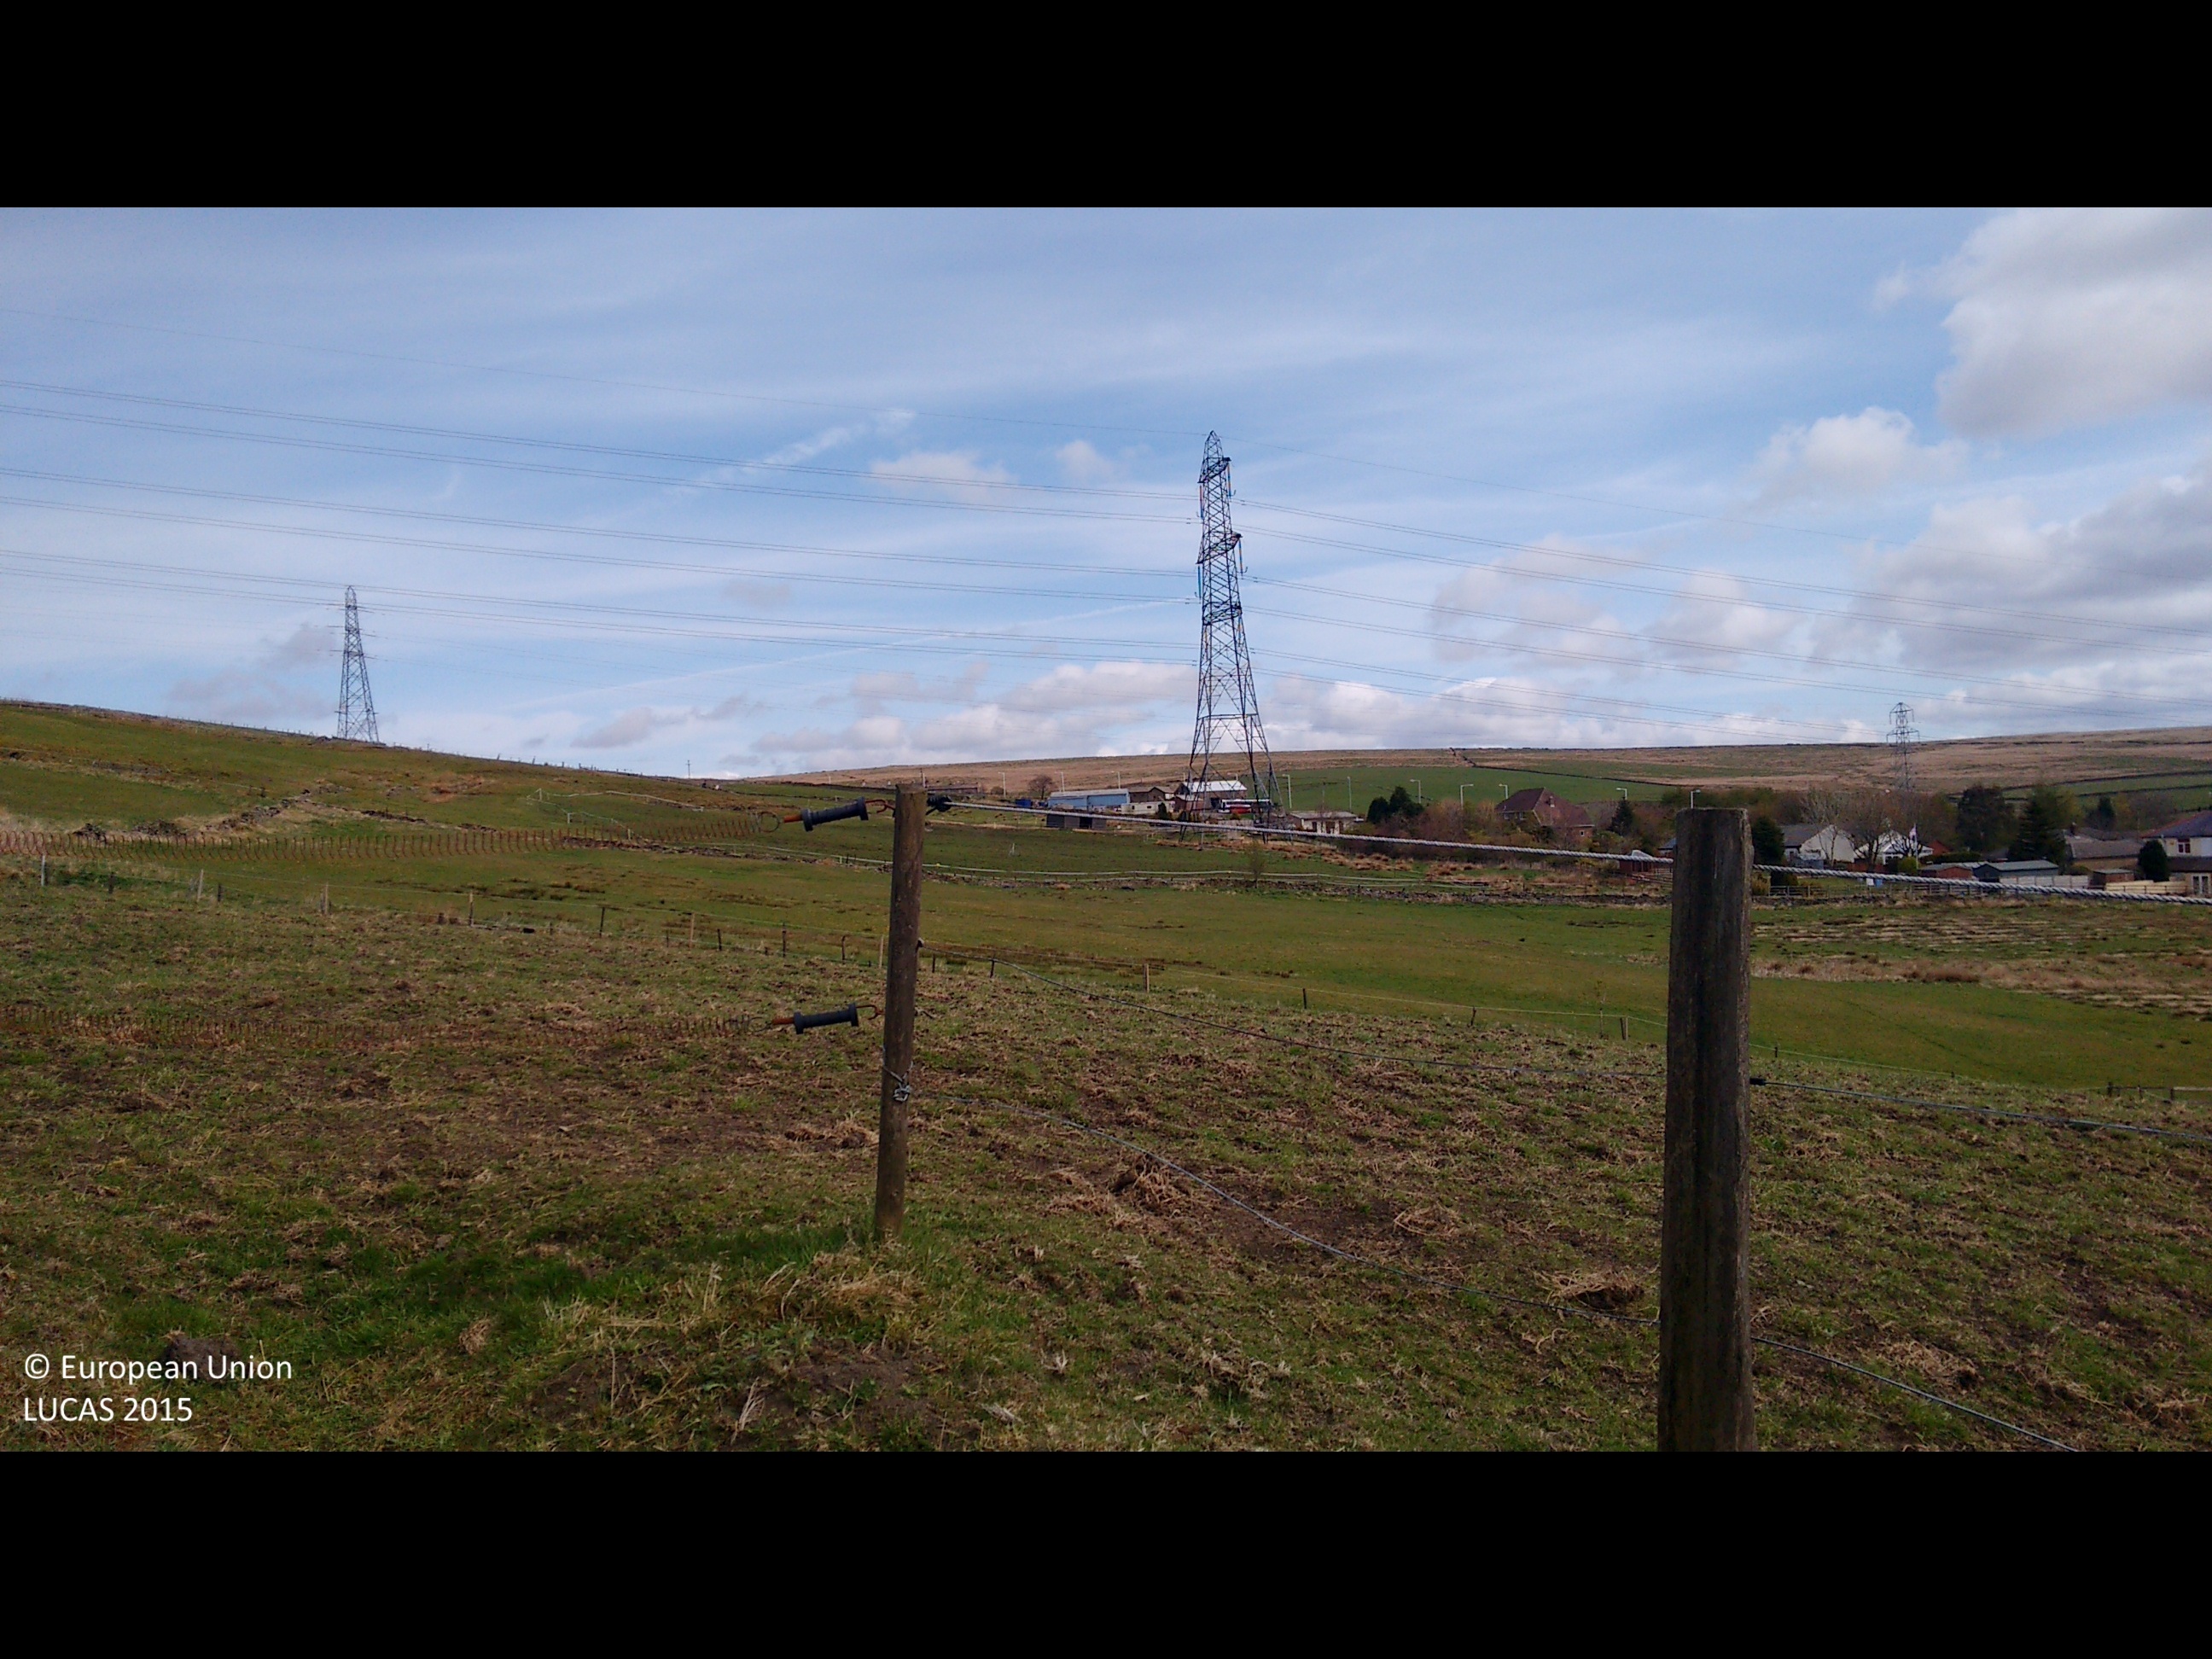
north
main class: Grassland
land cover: Grassland without tree/shrub cover
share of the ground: > 75 %
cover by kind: herbaceous plants 100 %
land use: Agriculture (excluding fallow land and kitchen gardens)
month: May
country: GB
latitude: 53.7282
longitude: -2.2011
